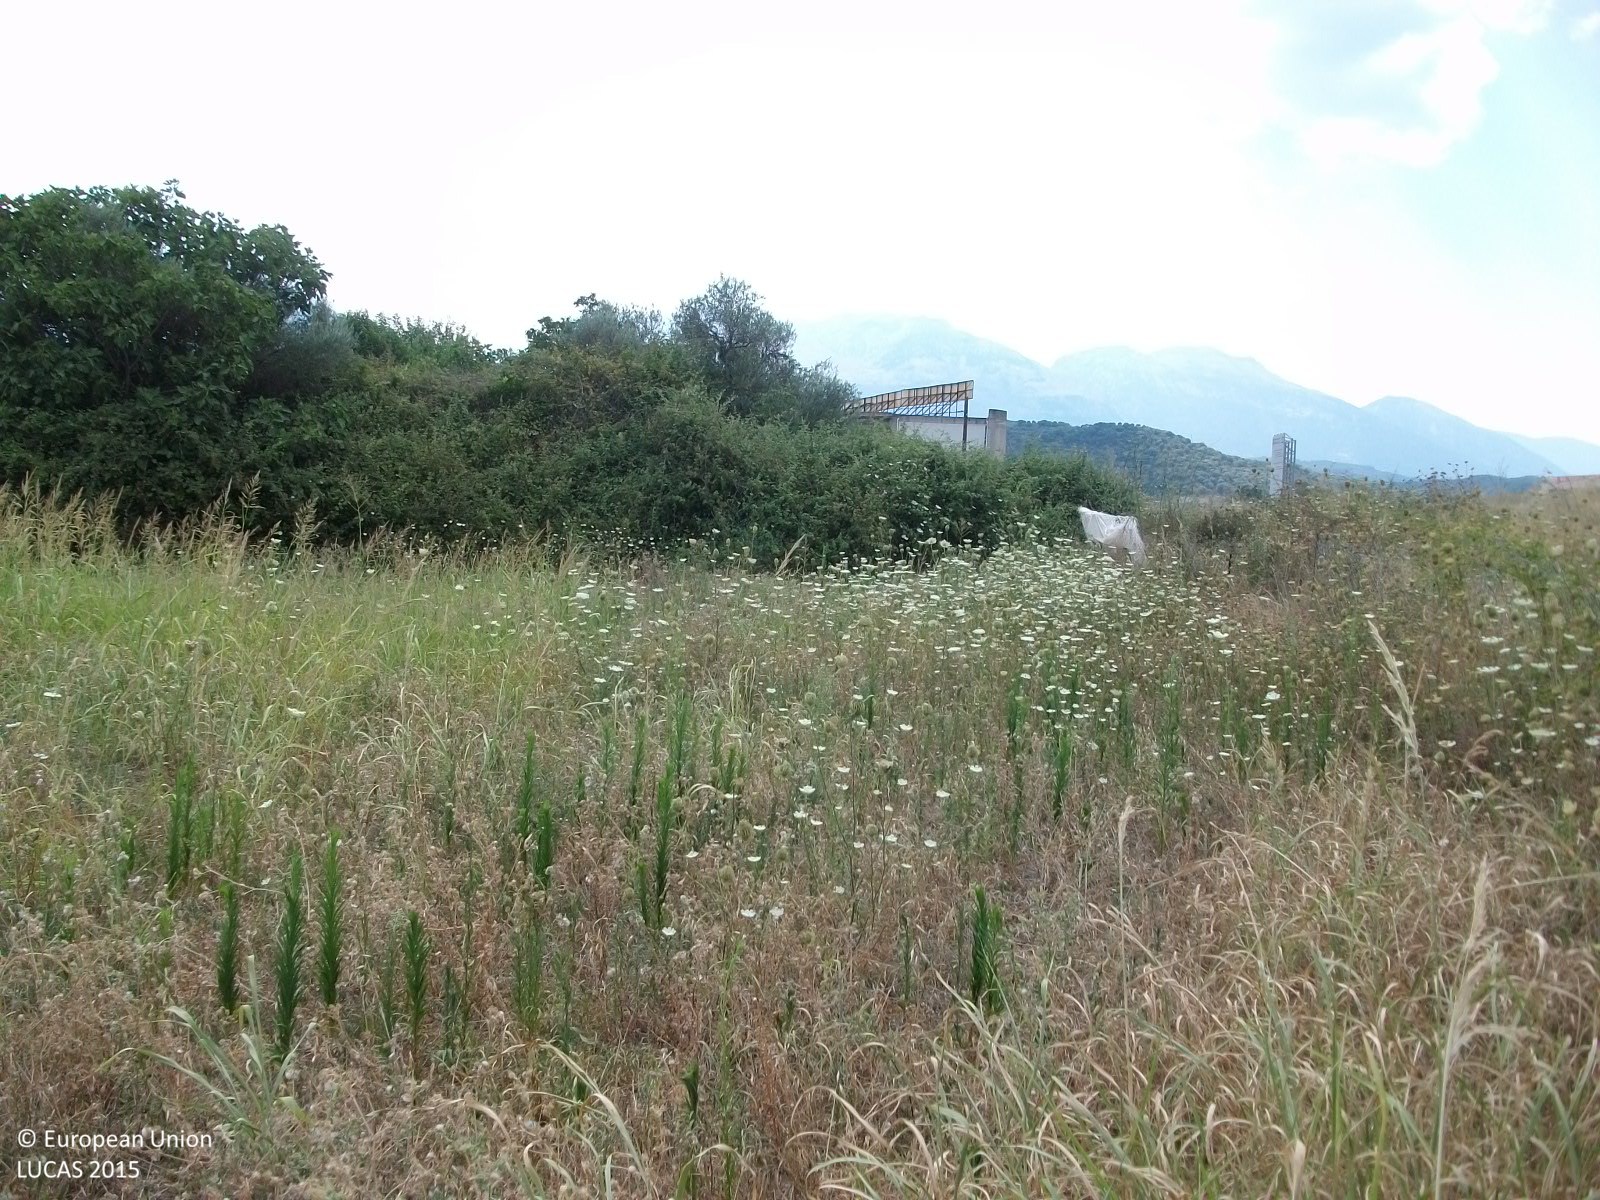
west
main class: Grassland
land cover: Spontaneously vegetated surfaces
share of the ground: > 75 %
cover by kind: herbaceous plants 95 %, shrubs 5 %
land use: Fallow land
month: July
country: GR
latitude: 37.0931
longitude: 22.4334
